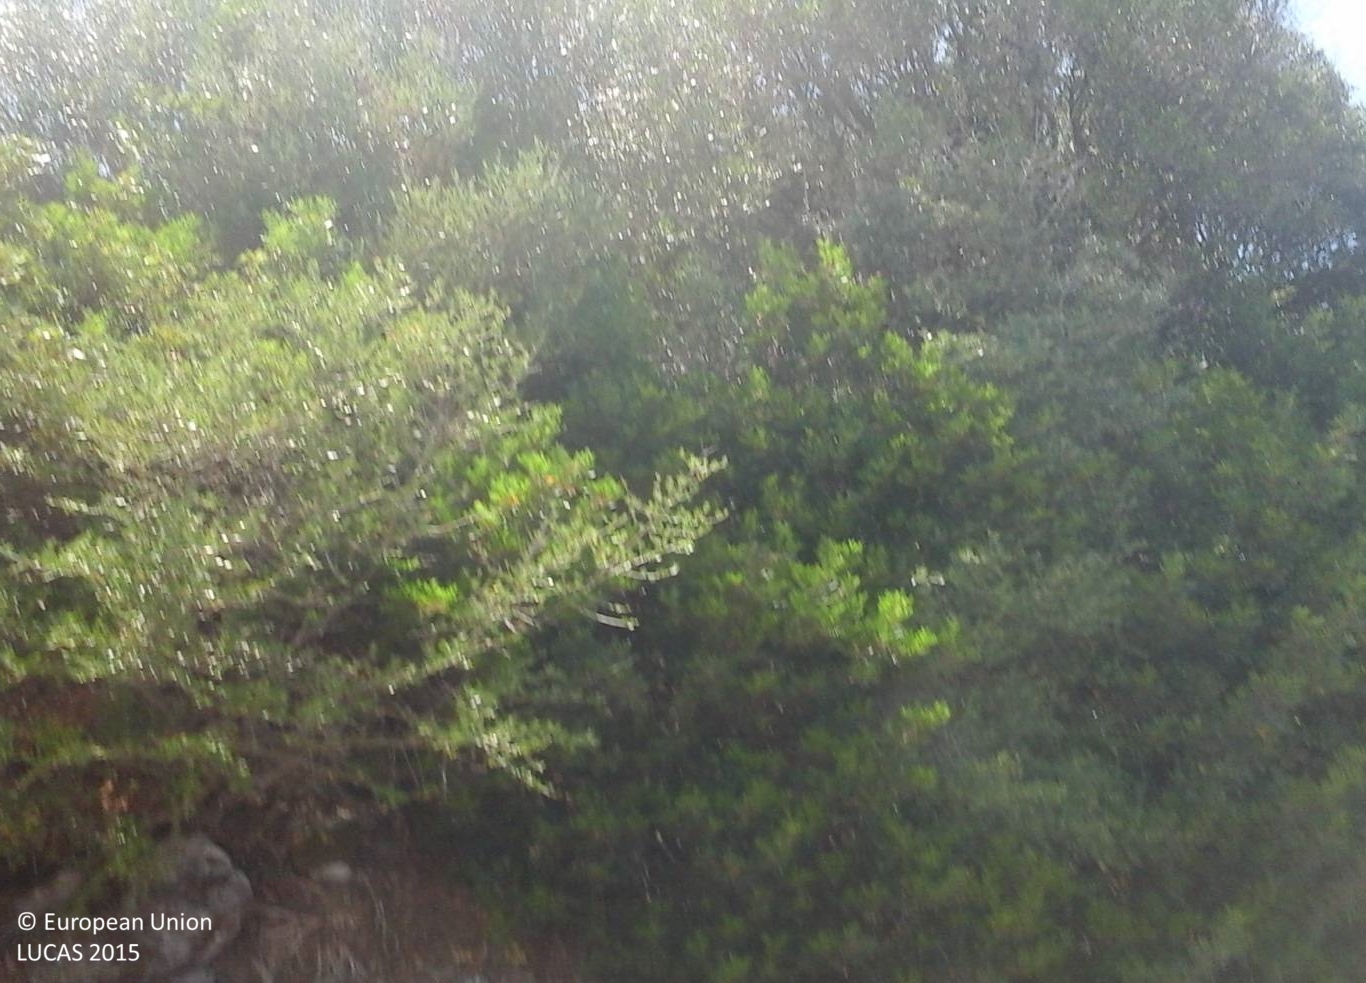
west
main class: Shrubland
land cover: Shrubland without tree cover
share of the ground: > 75 %
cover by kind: shrubs 55 %, unconsolidated bare surface 30 %, herbaceous plants 15 %
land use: Semi-natural and natural areas not in use
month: July
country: IT
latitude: 39.1521
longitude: 8.5856
